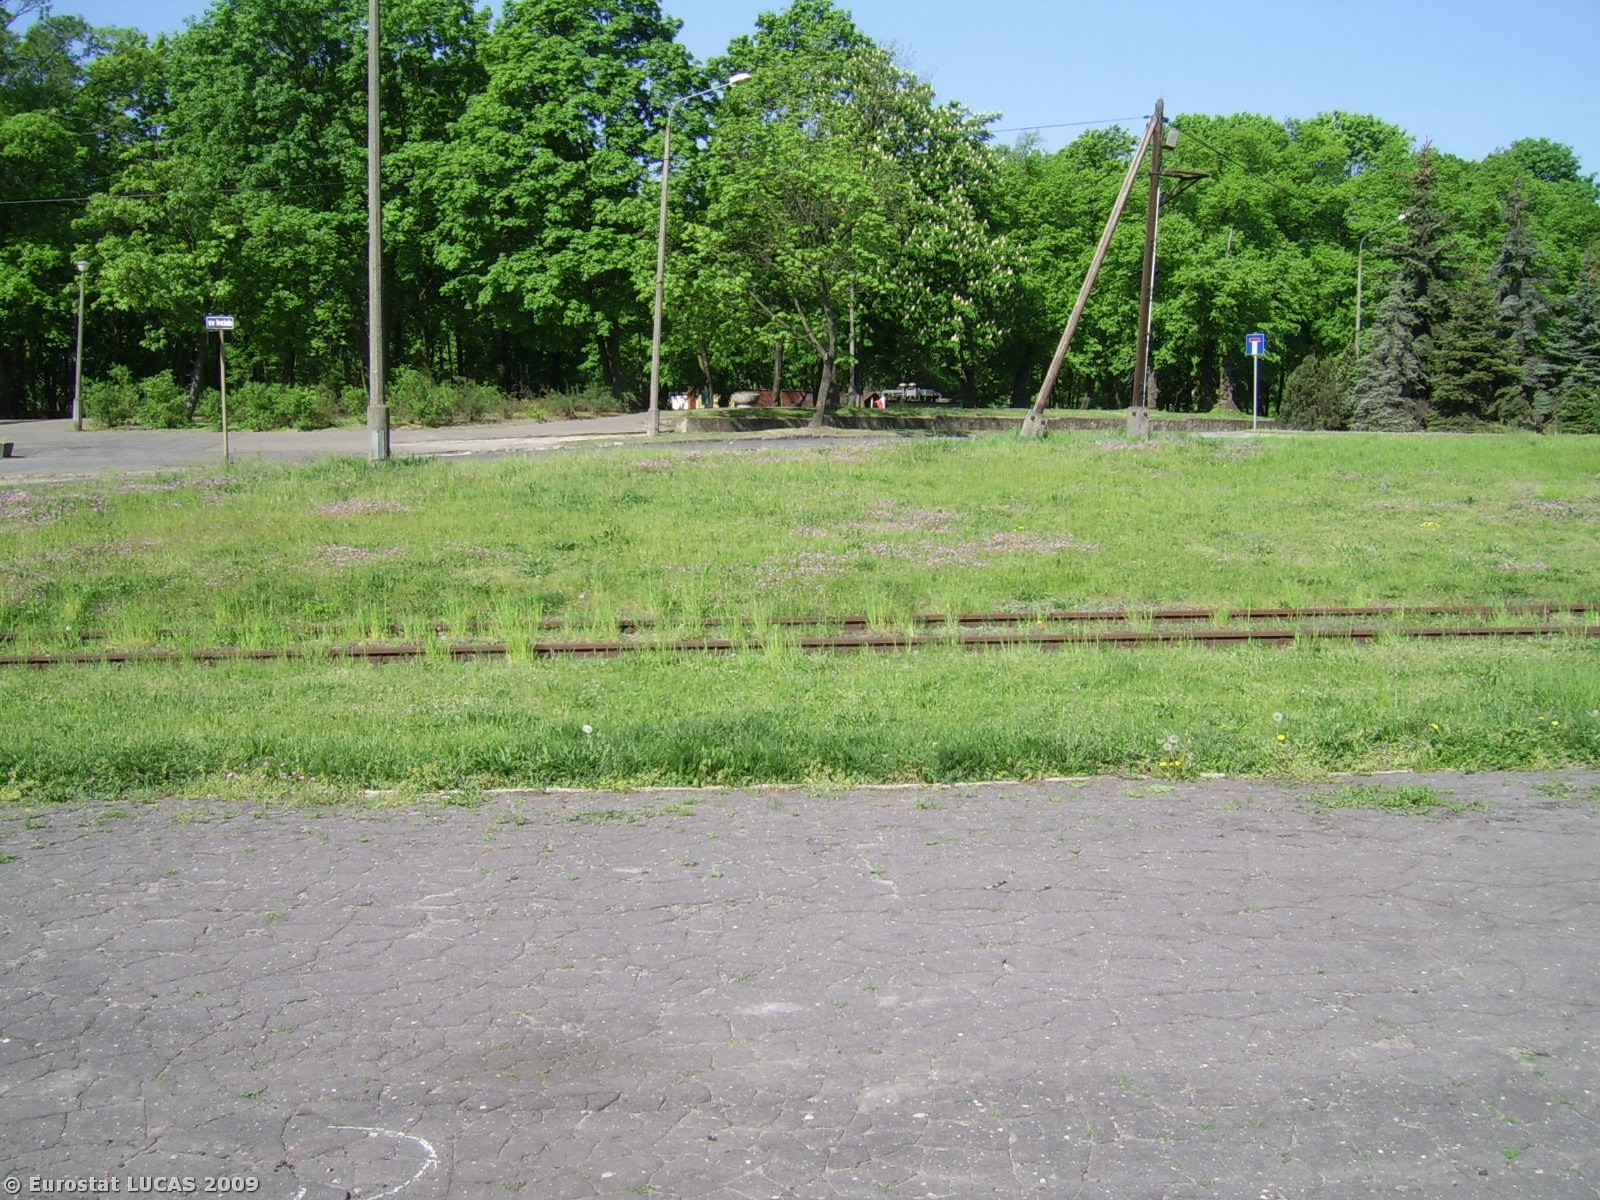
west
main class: Grassland
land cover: Grassland without tree/shrub cover
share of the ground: > 75 %
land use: Amenities, museums, leisure
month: May
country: PL
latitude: 52.4076
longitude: 16.9627
